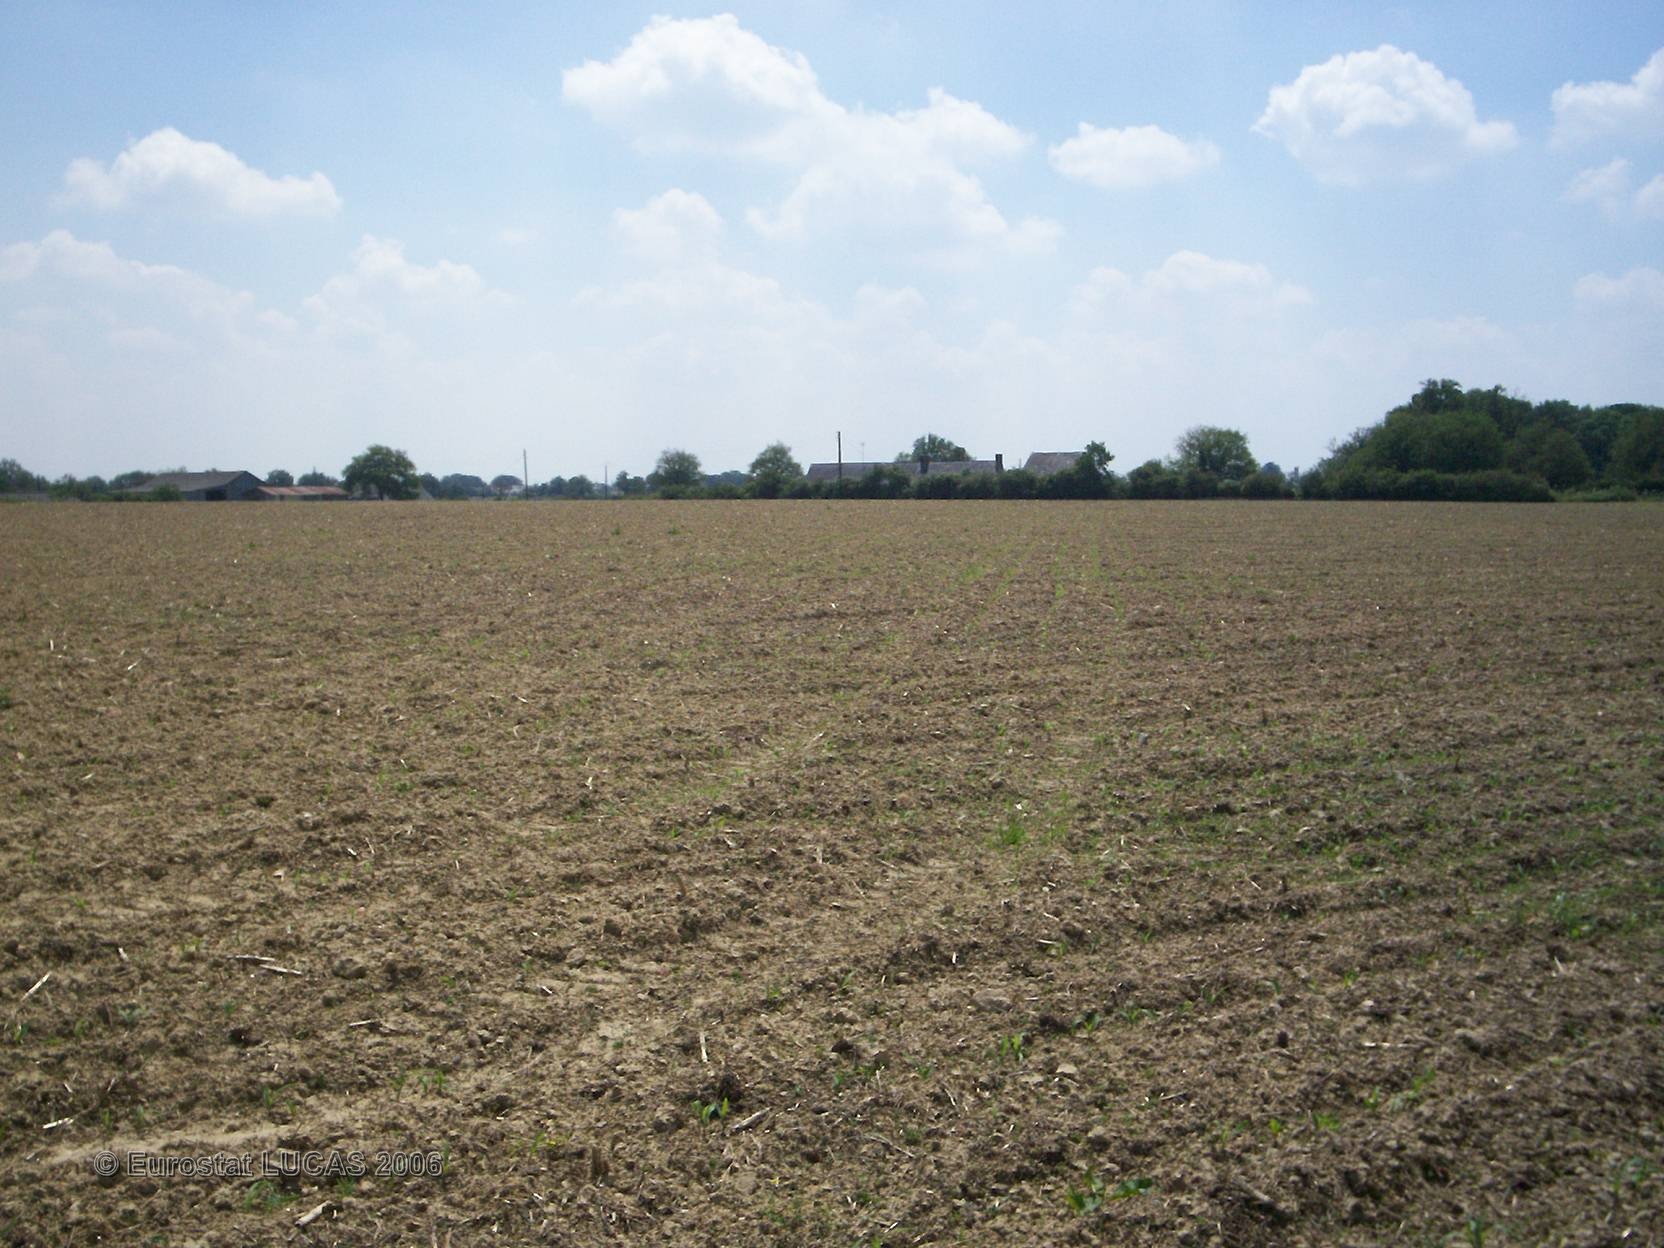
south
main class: Cropland
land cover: Maize
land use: Agriculture (excluding fallow land and kitchen gardens)
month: June
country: FR
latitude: 47.6020
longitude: -1.1451
